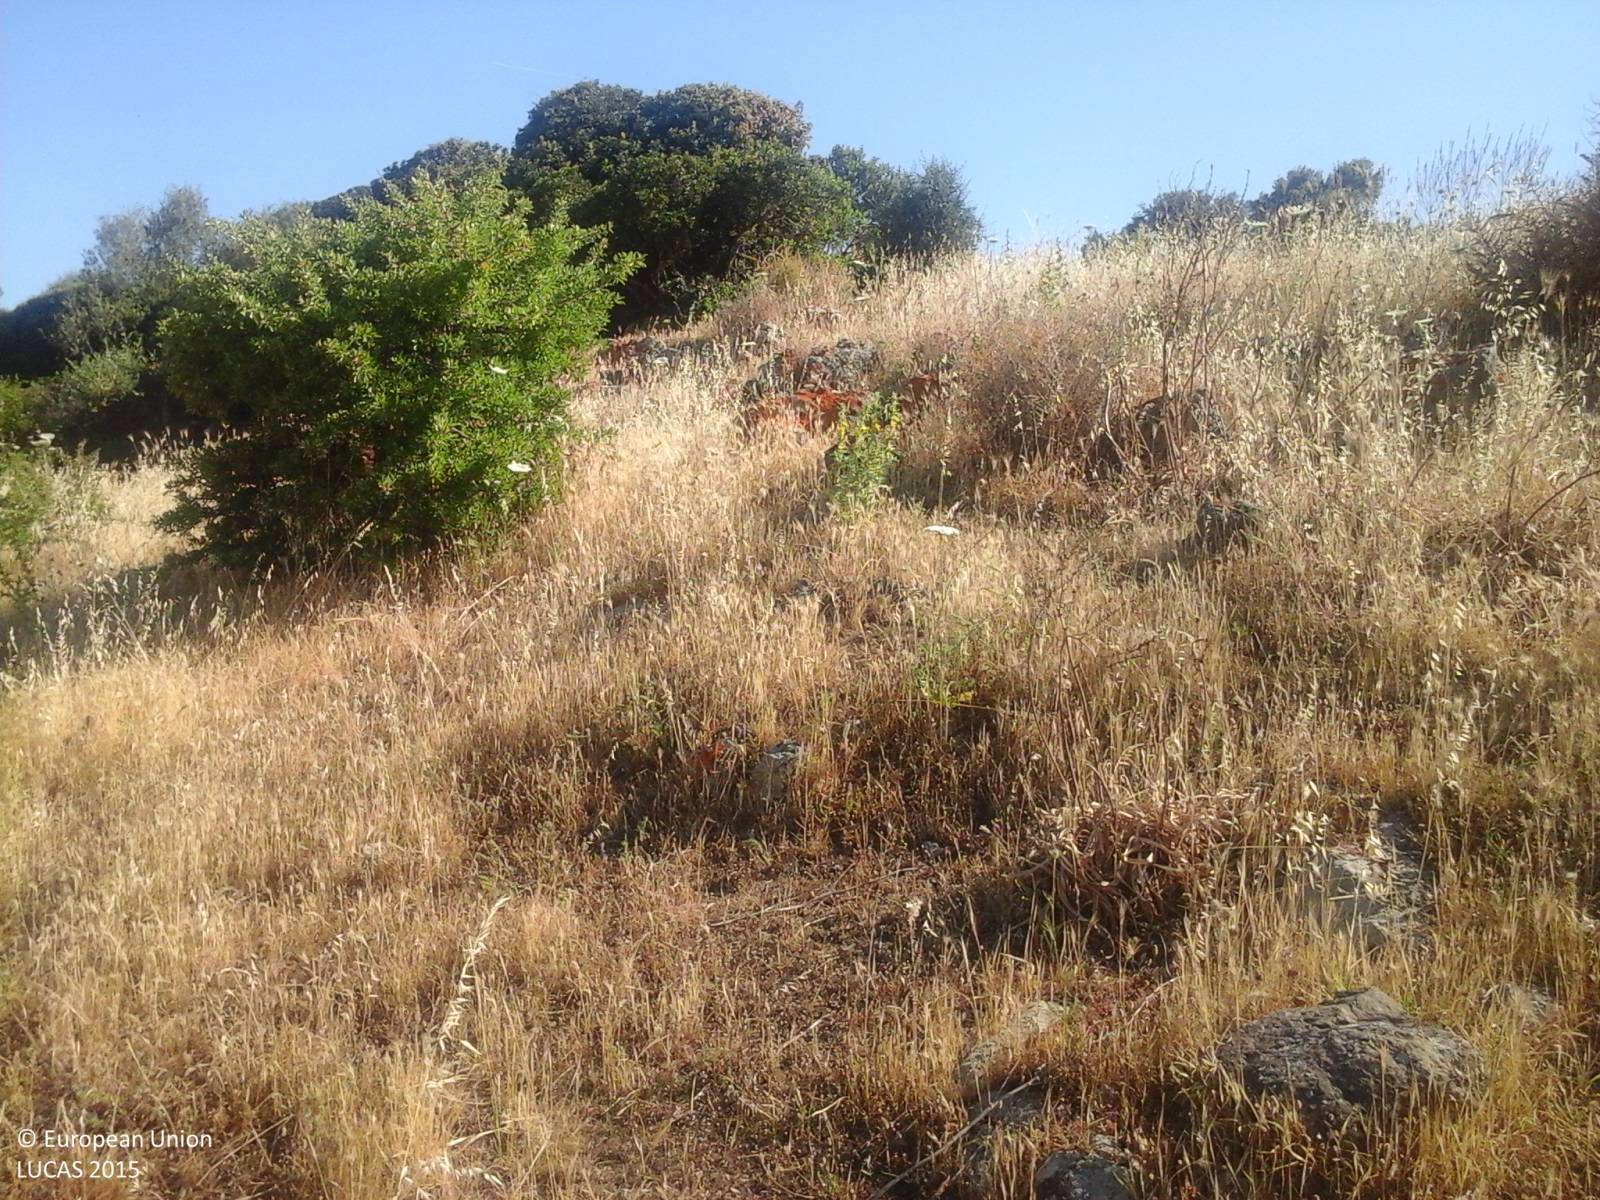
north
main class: Grassland
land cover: Grassland with sparse tree/shrub cover
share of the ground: > 75 %
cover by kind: herbaceous plants 90 %, broadleaved forest trees 5 %, shrubs 5 %
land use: Agriculture (excluding fallow land and kitchen gardens)
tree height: < 5 m
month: June
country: IT
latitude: 40.5992
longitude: 8.4595
